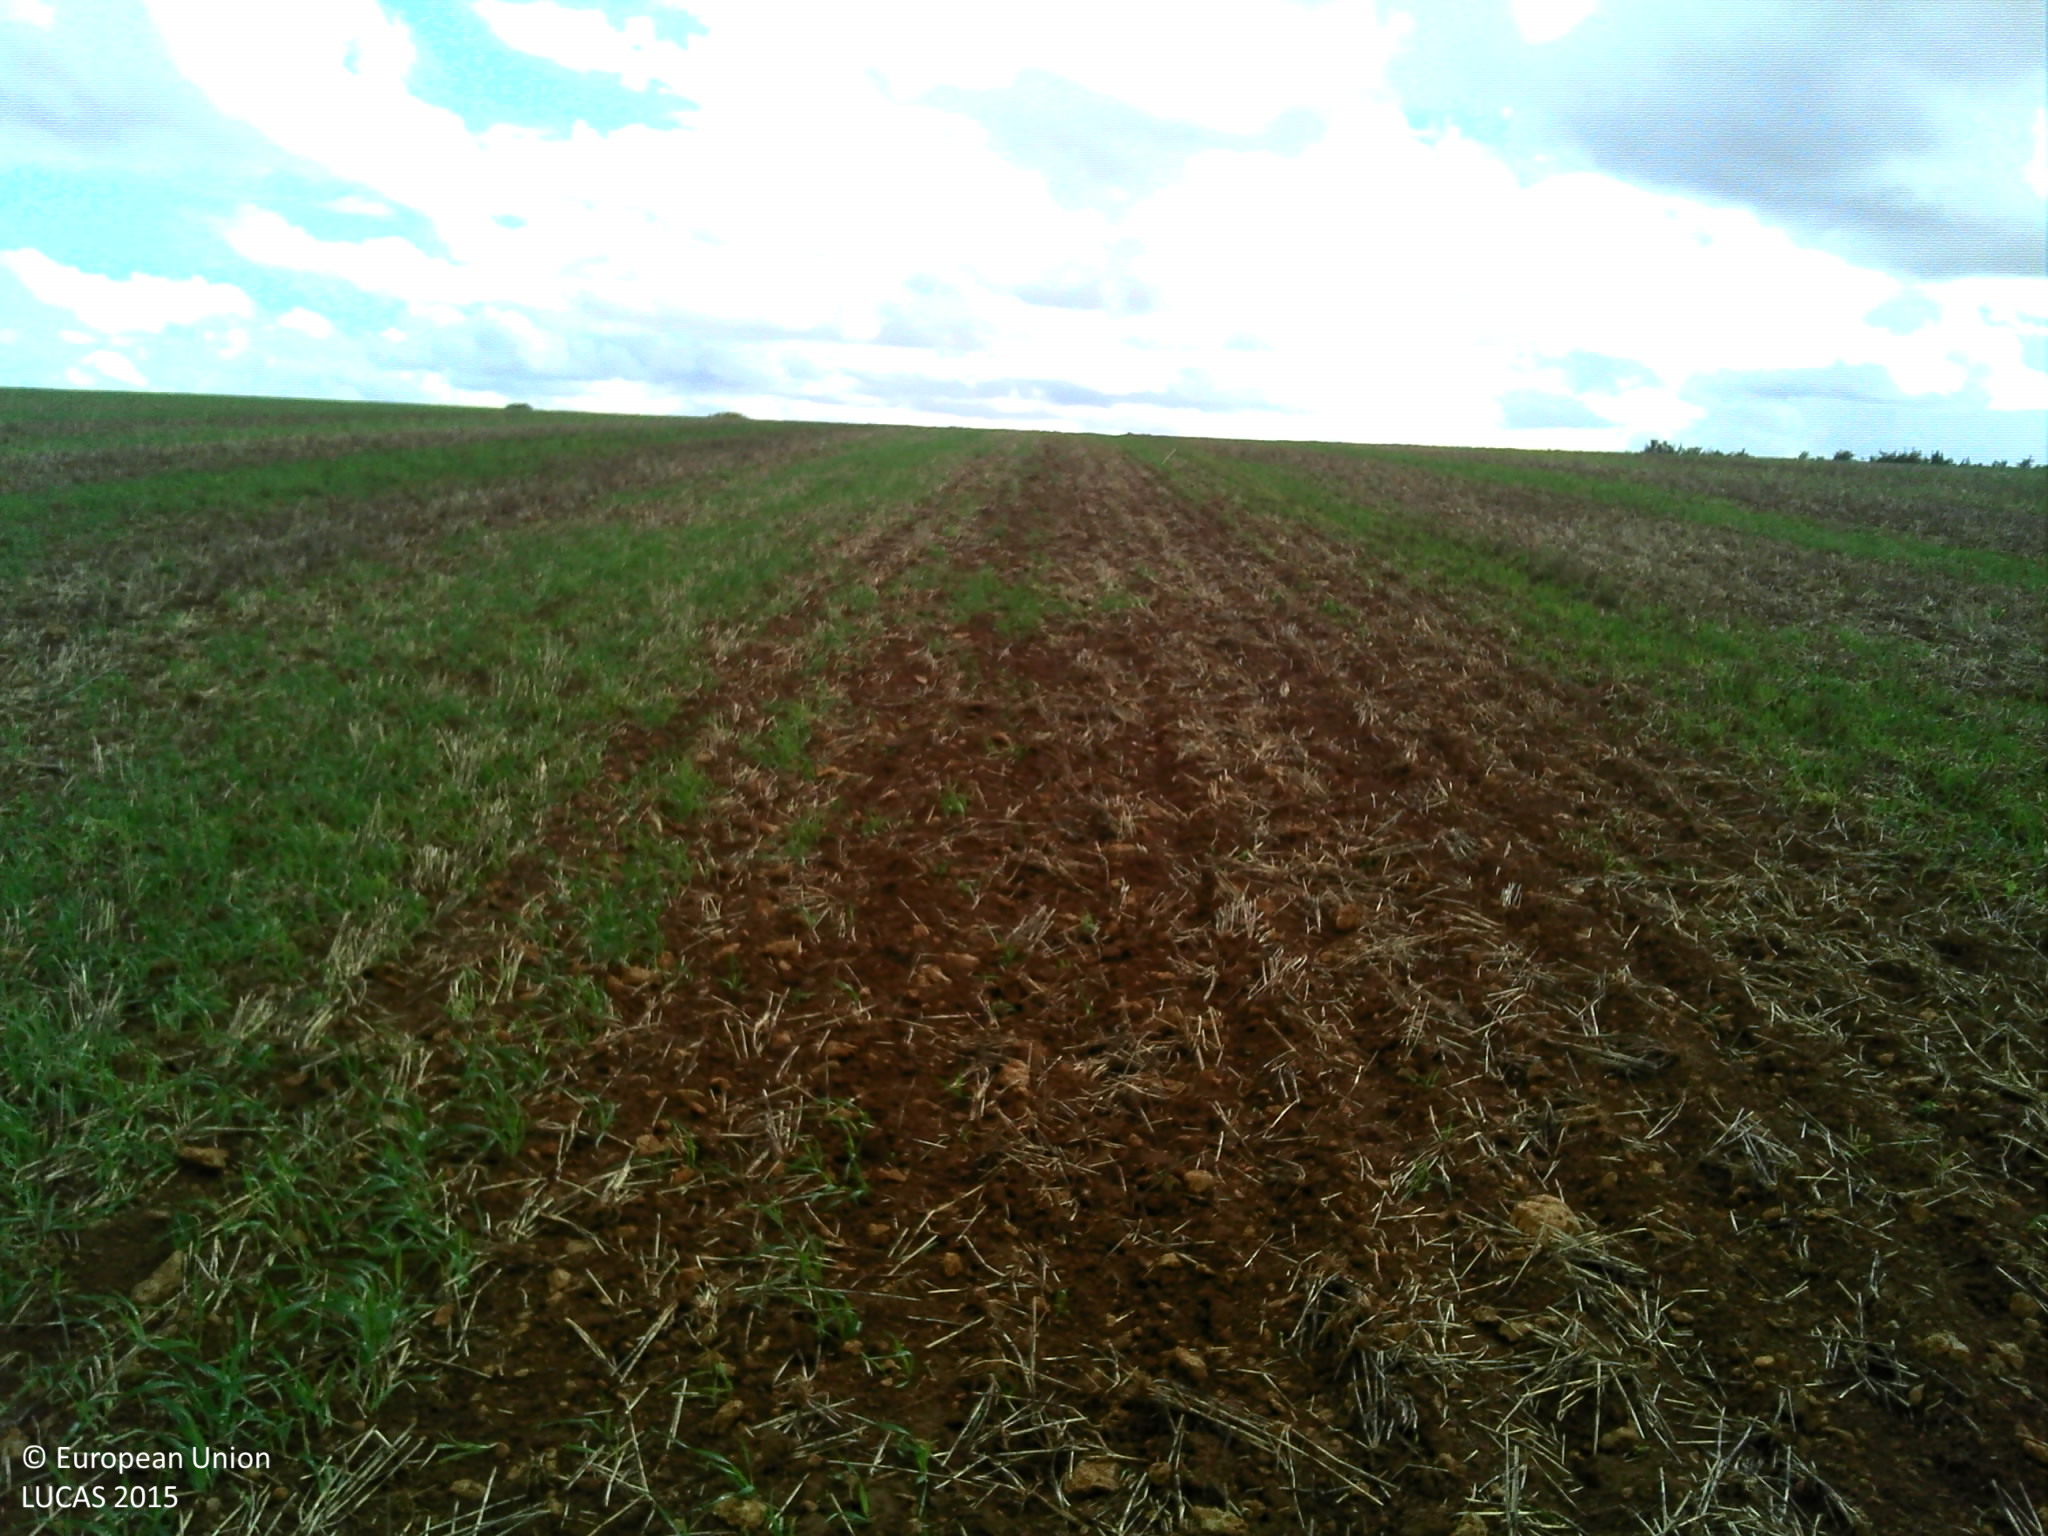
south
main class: Cropland
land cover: Common wheat
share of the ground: < 10 %
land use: Agriculture (excluding fallow land and kitchen gardens)
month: September
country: FR
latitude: 48.8867
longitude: 5.9218
